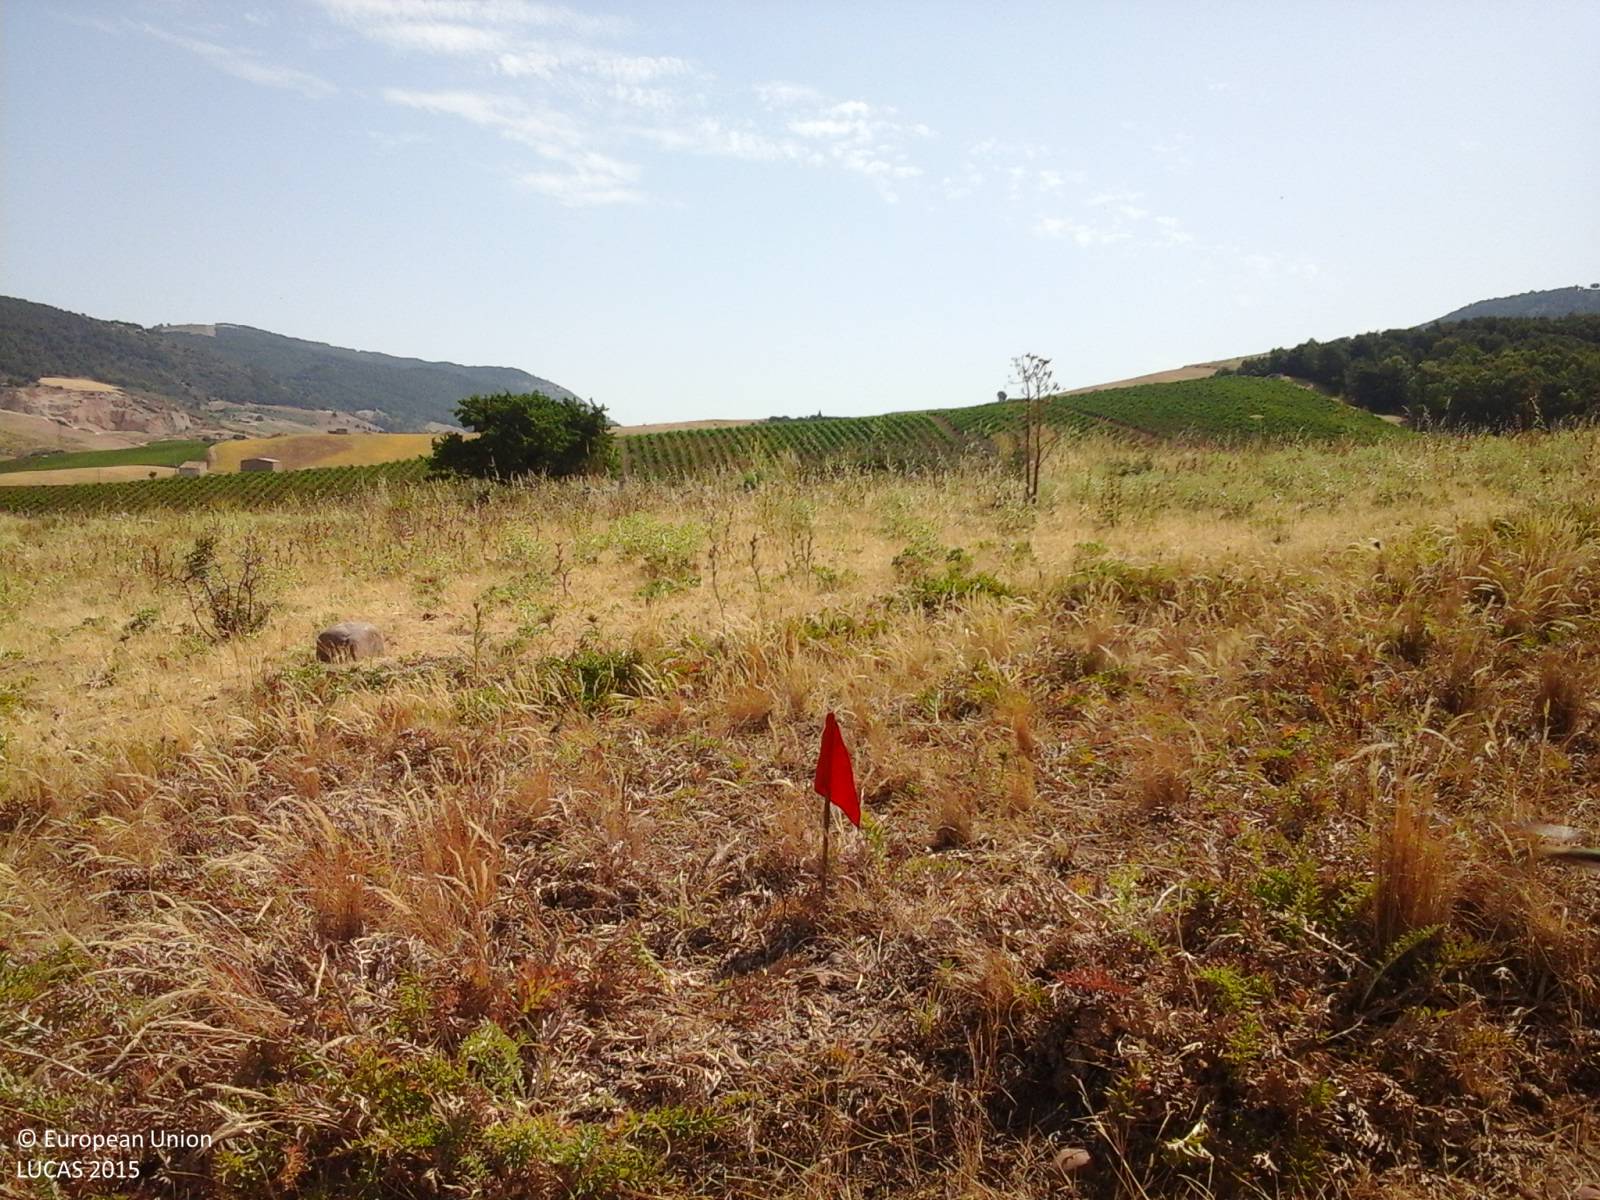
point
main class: Grassland
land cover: Grassland without tree/shrub cover
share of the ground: > 75 %
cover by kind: herbaceous plants 100 %
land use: Agriculture (excluding fallow land and kitchen gardens)
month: June
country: IT
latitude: 37.8708
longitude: 12.7648
